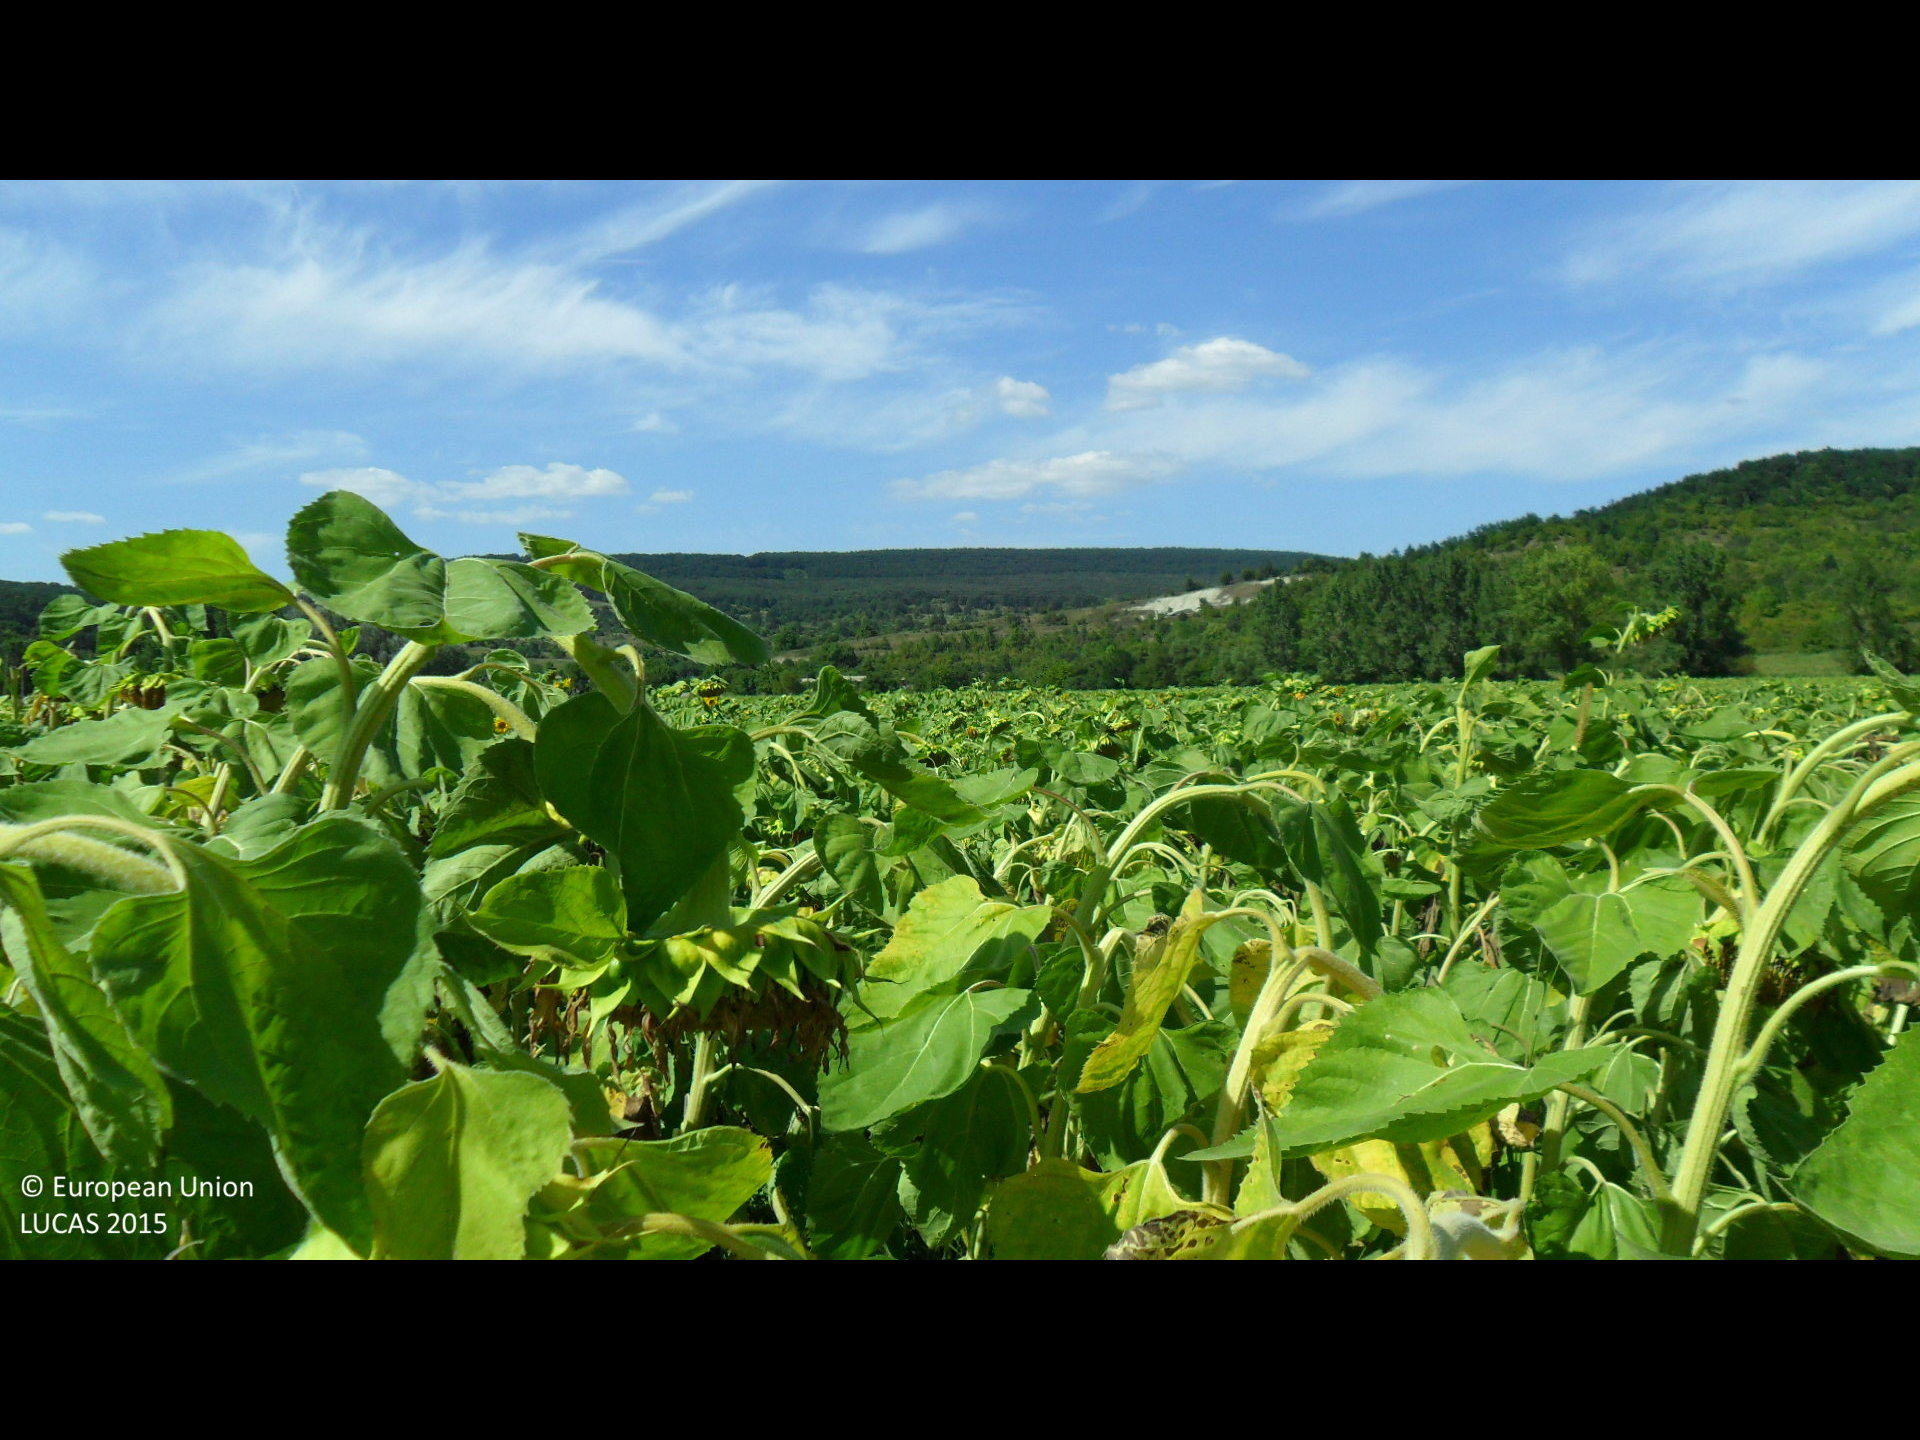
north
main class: Cropland
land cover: Sunflower
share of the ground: > 75 %
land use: Agriculture (excluding fallow land and kitchen gardens)
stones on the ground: < 10 %
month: August
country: BG
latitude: 43.3206
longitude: 26.3386
